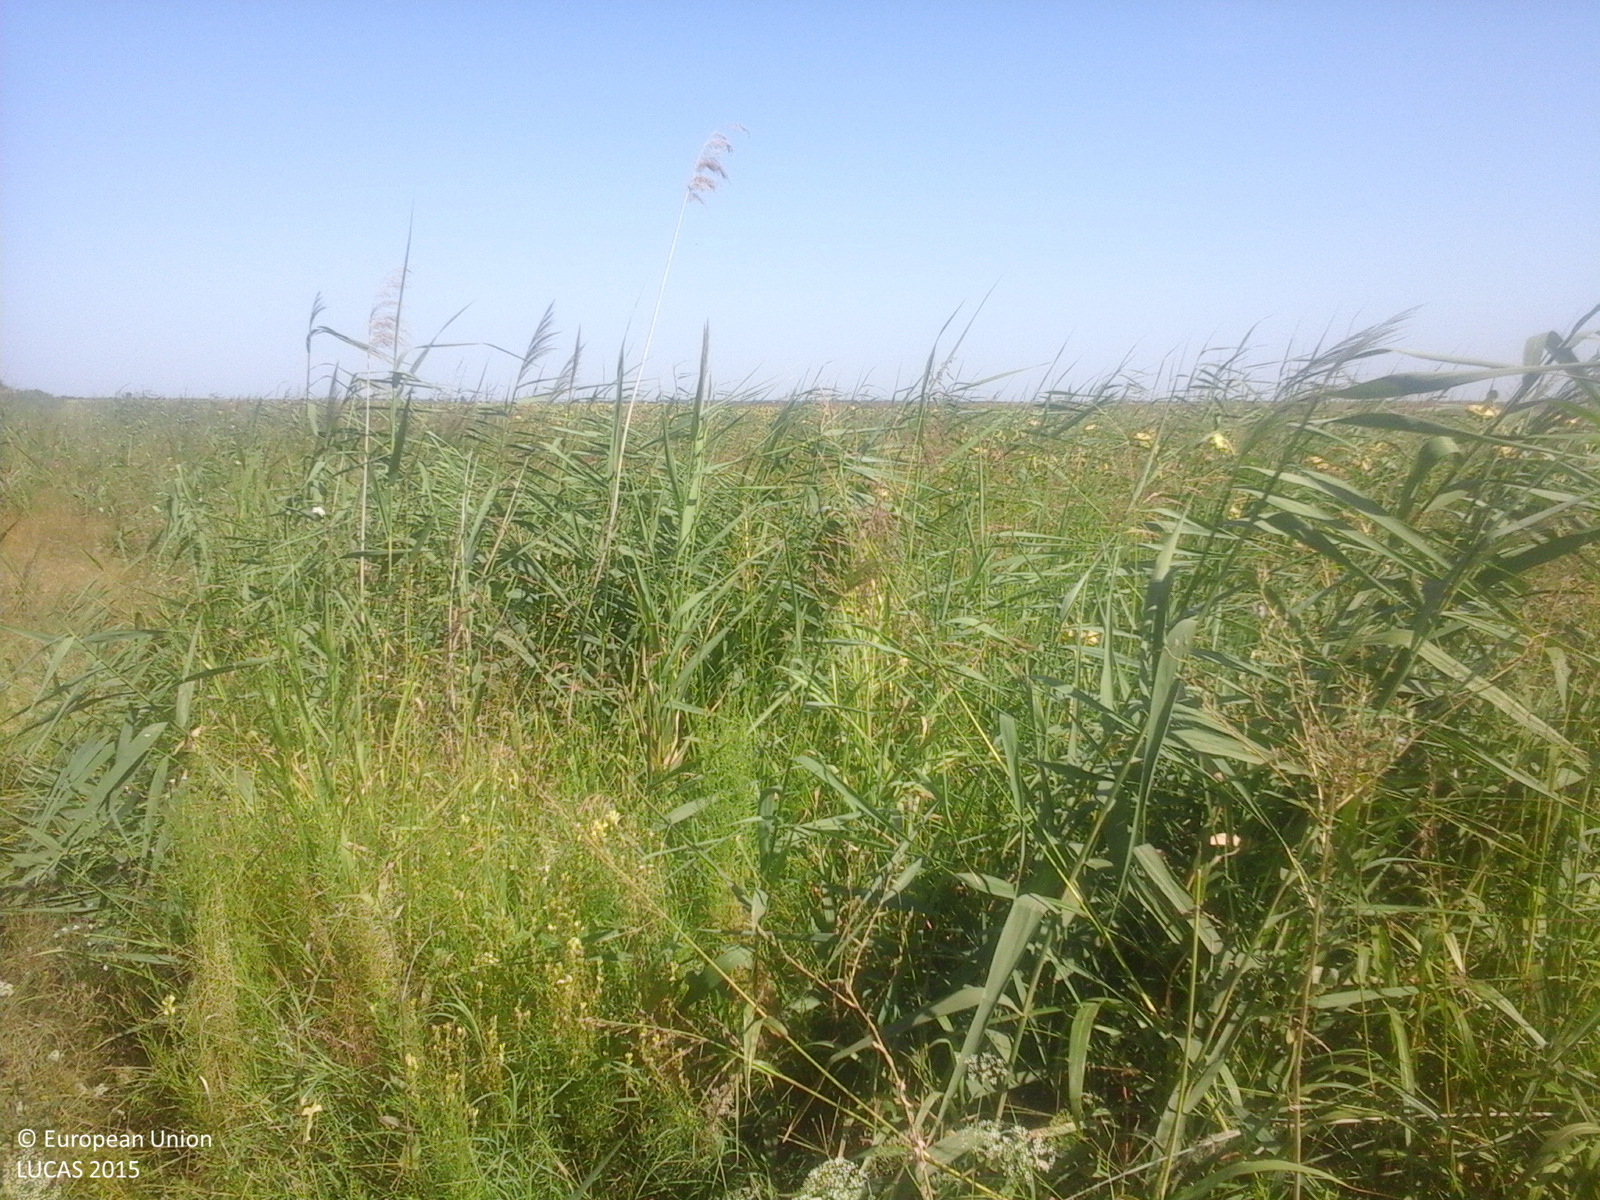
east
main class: Cropland
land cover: Sunflower
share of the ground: > 75 %
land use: Agriculture (excluding fallow land and kitchen gardens)
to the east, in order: Sunflower
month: August
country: RO
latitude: 45.5632
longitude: 27.4620
